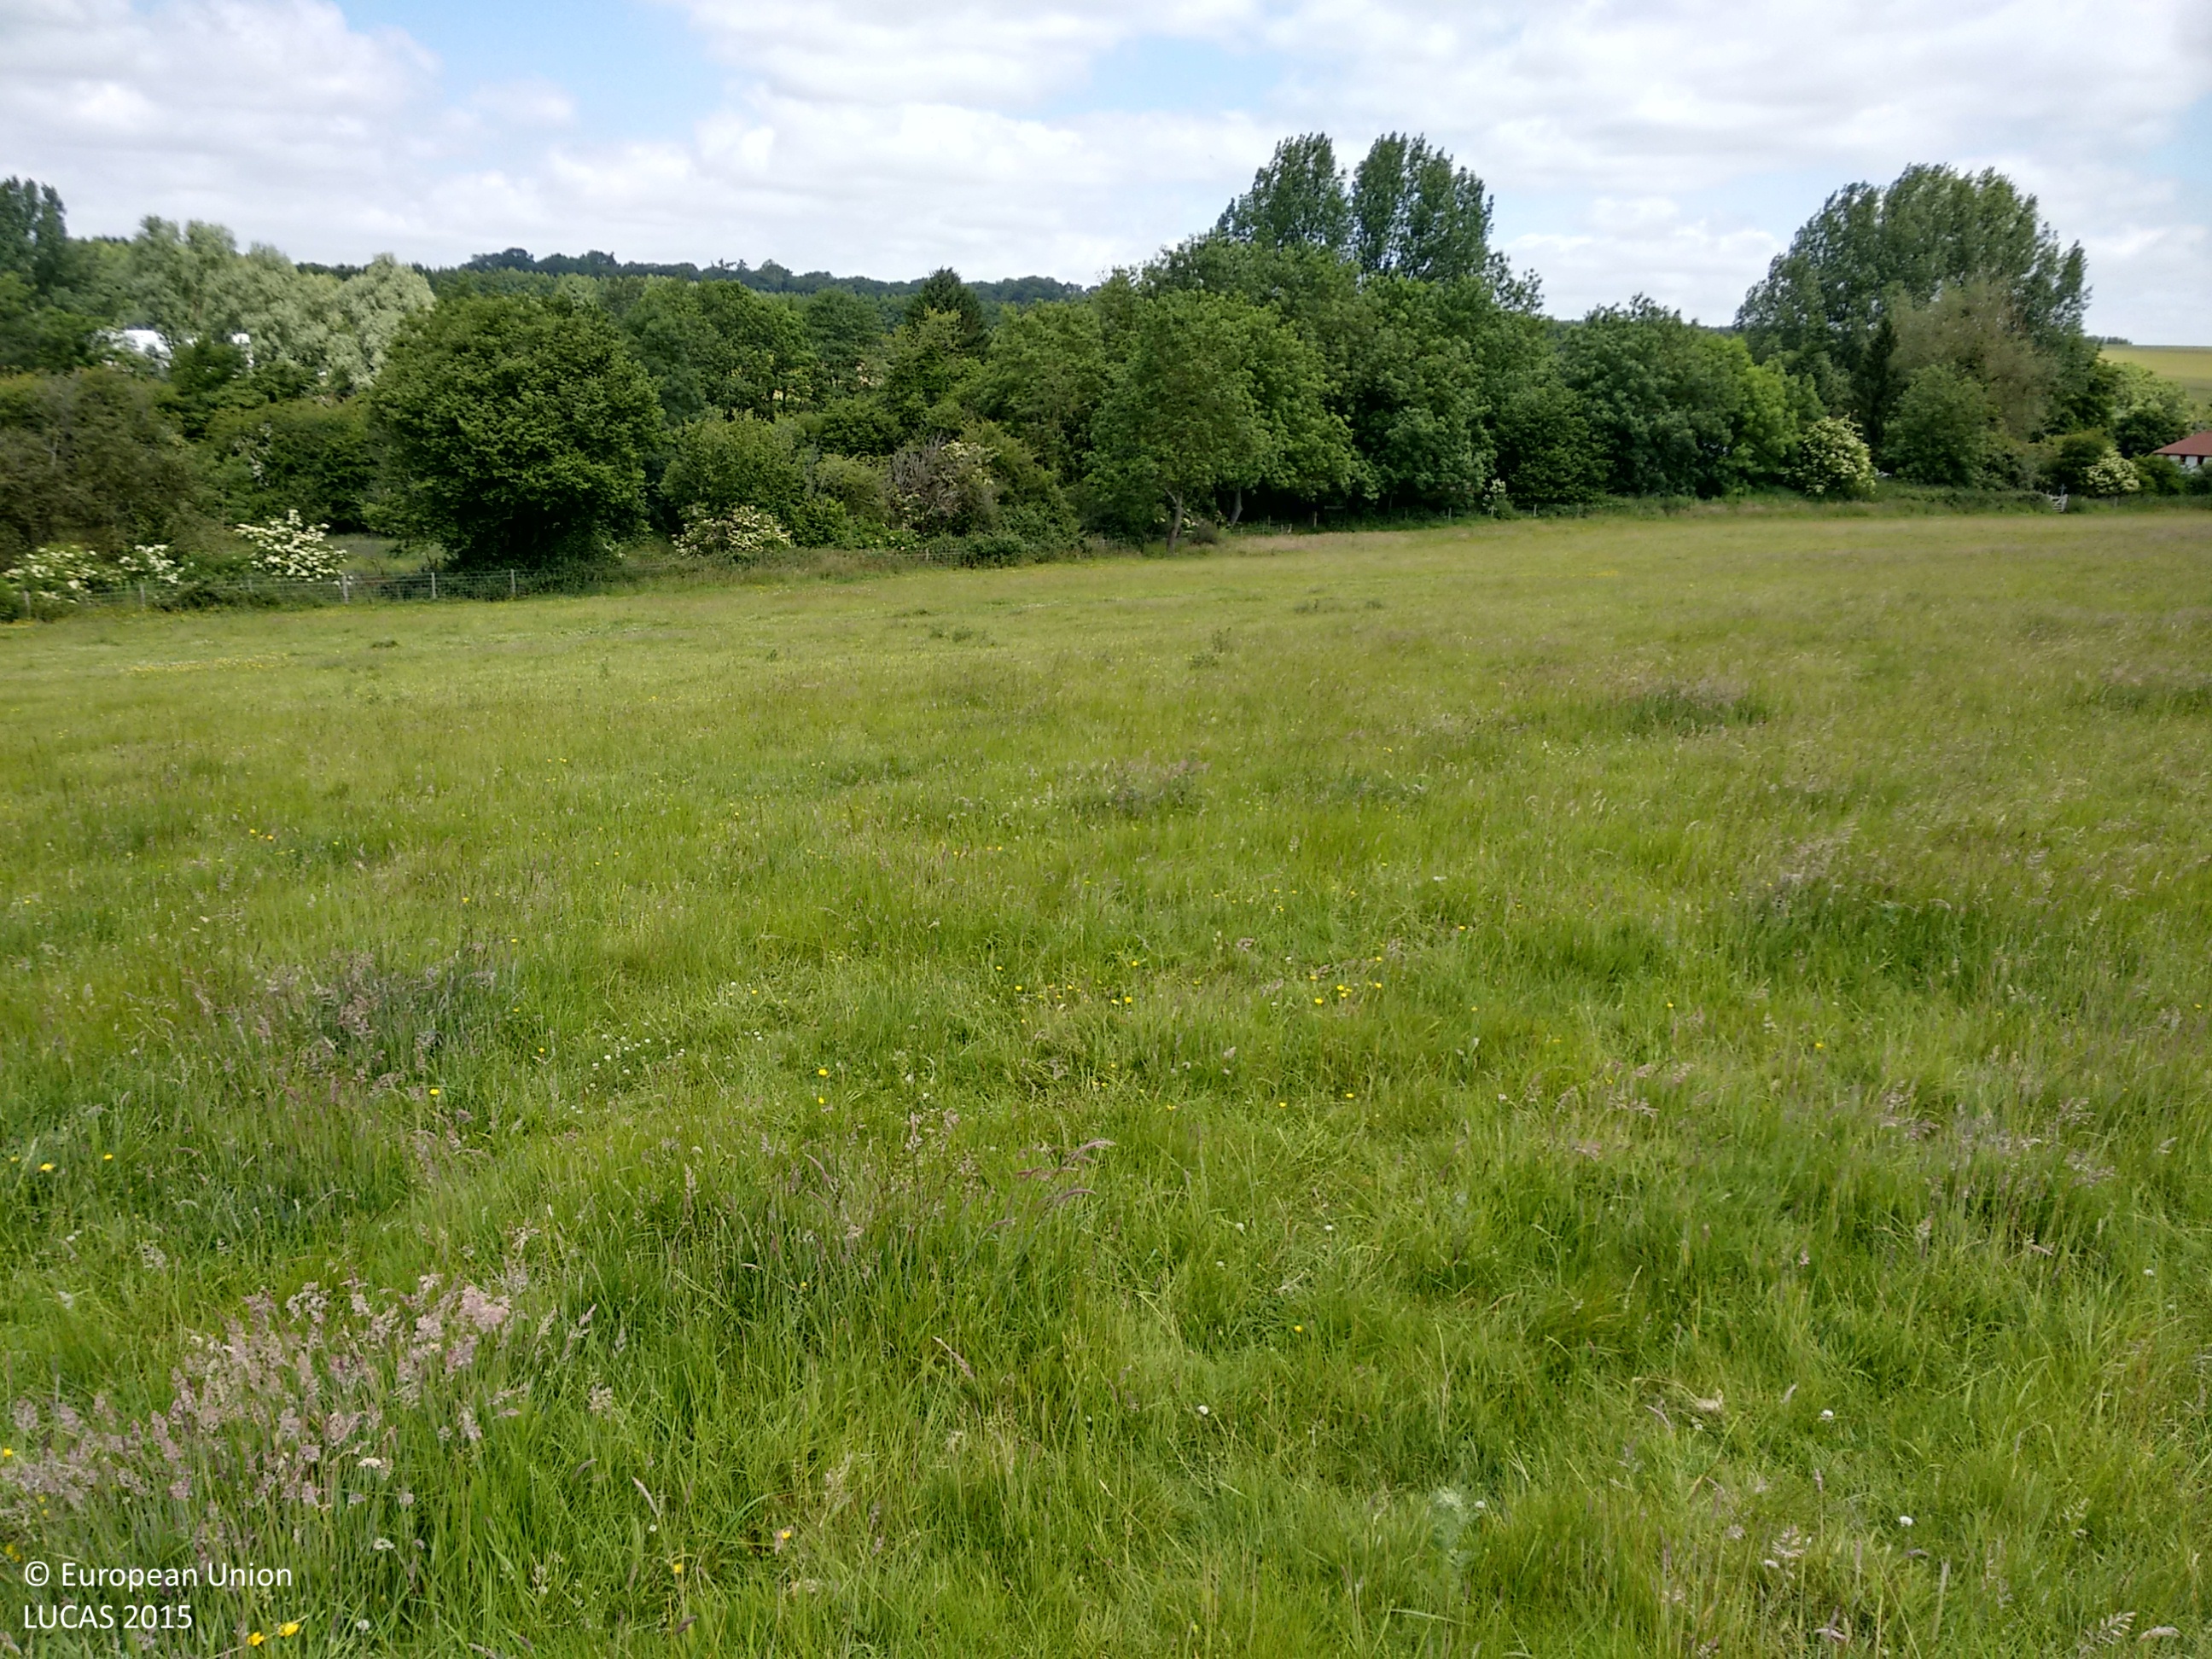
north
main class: Grassland
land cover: Grassland without tree/shrub cover
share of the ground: > 75 %
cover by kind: herbaceous plants 100 %
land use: Agriculture (excluding fallow land and kitchen gardens)
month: June
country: GB
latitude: 51.4128
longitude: -1.5398
